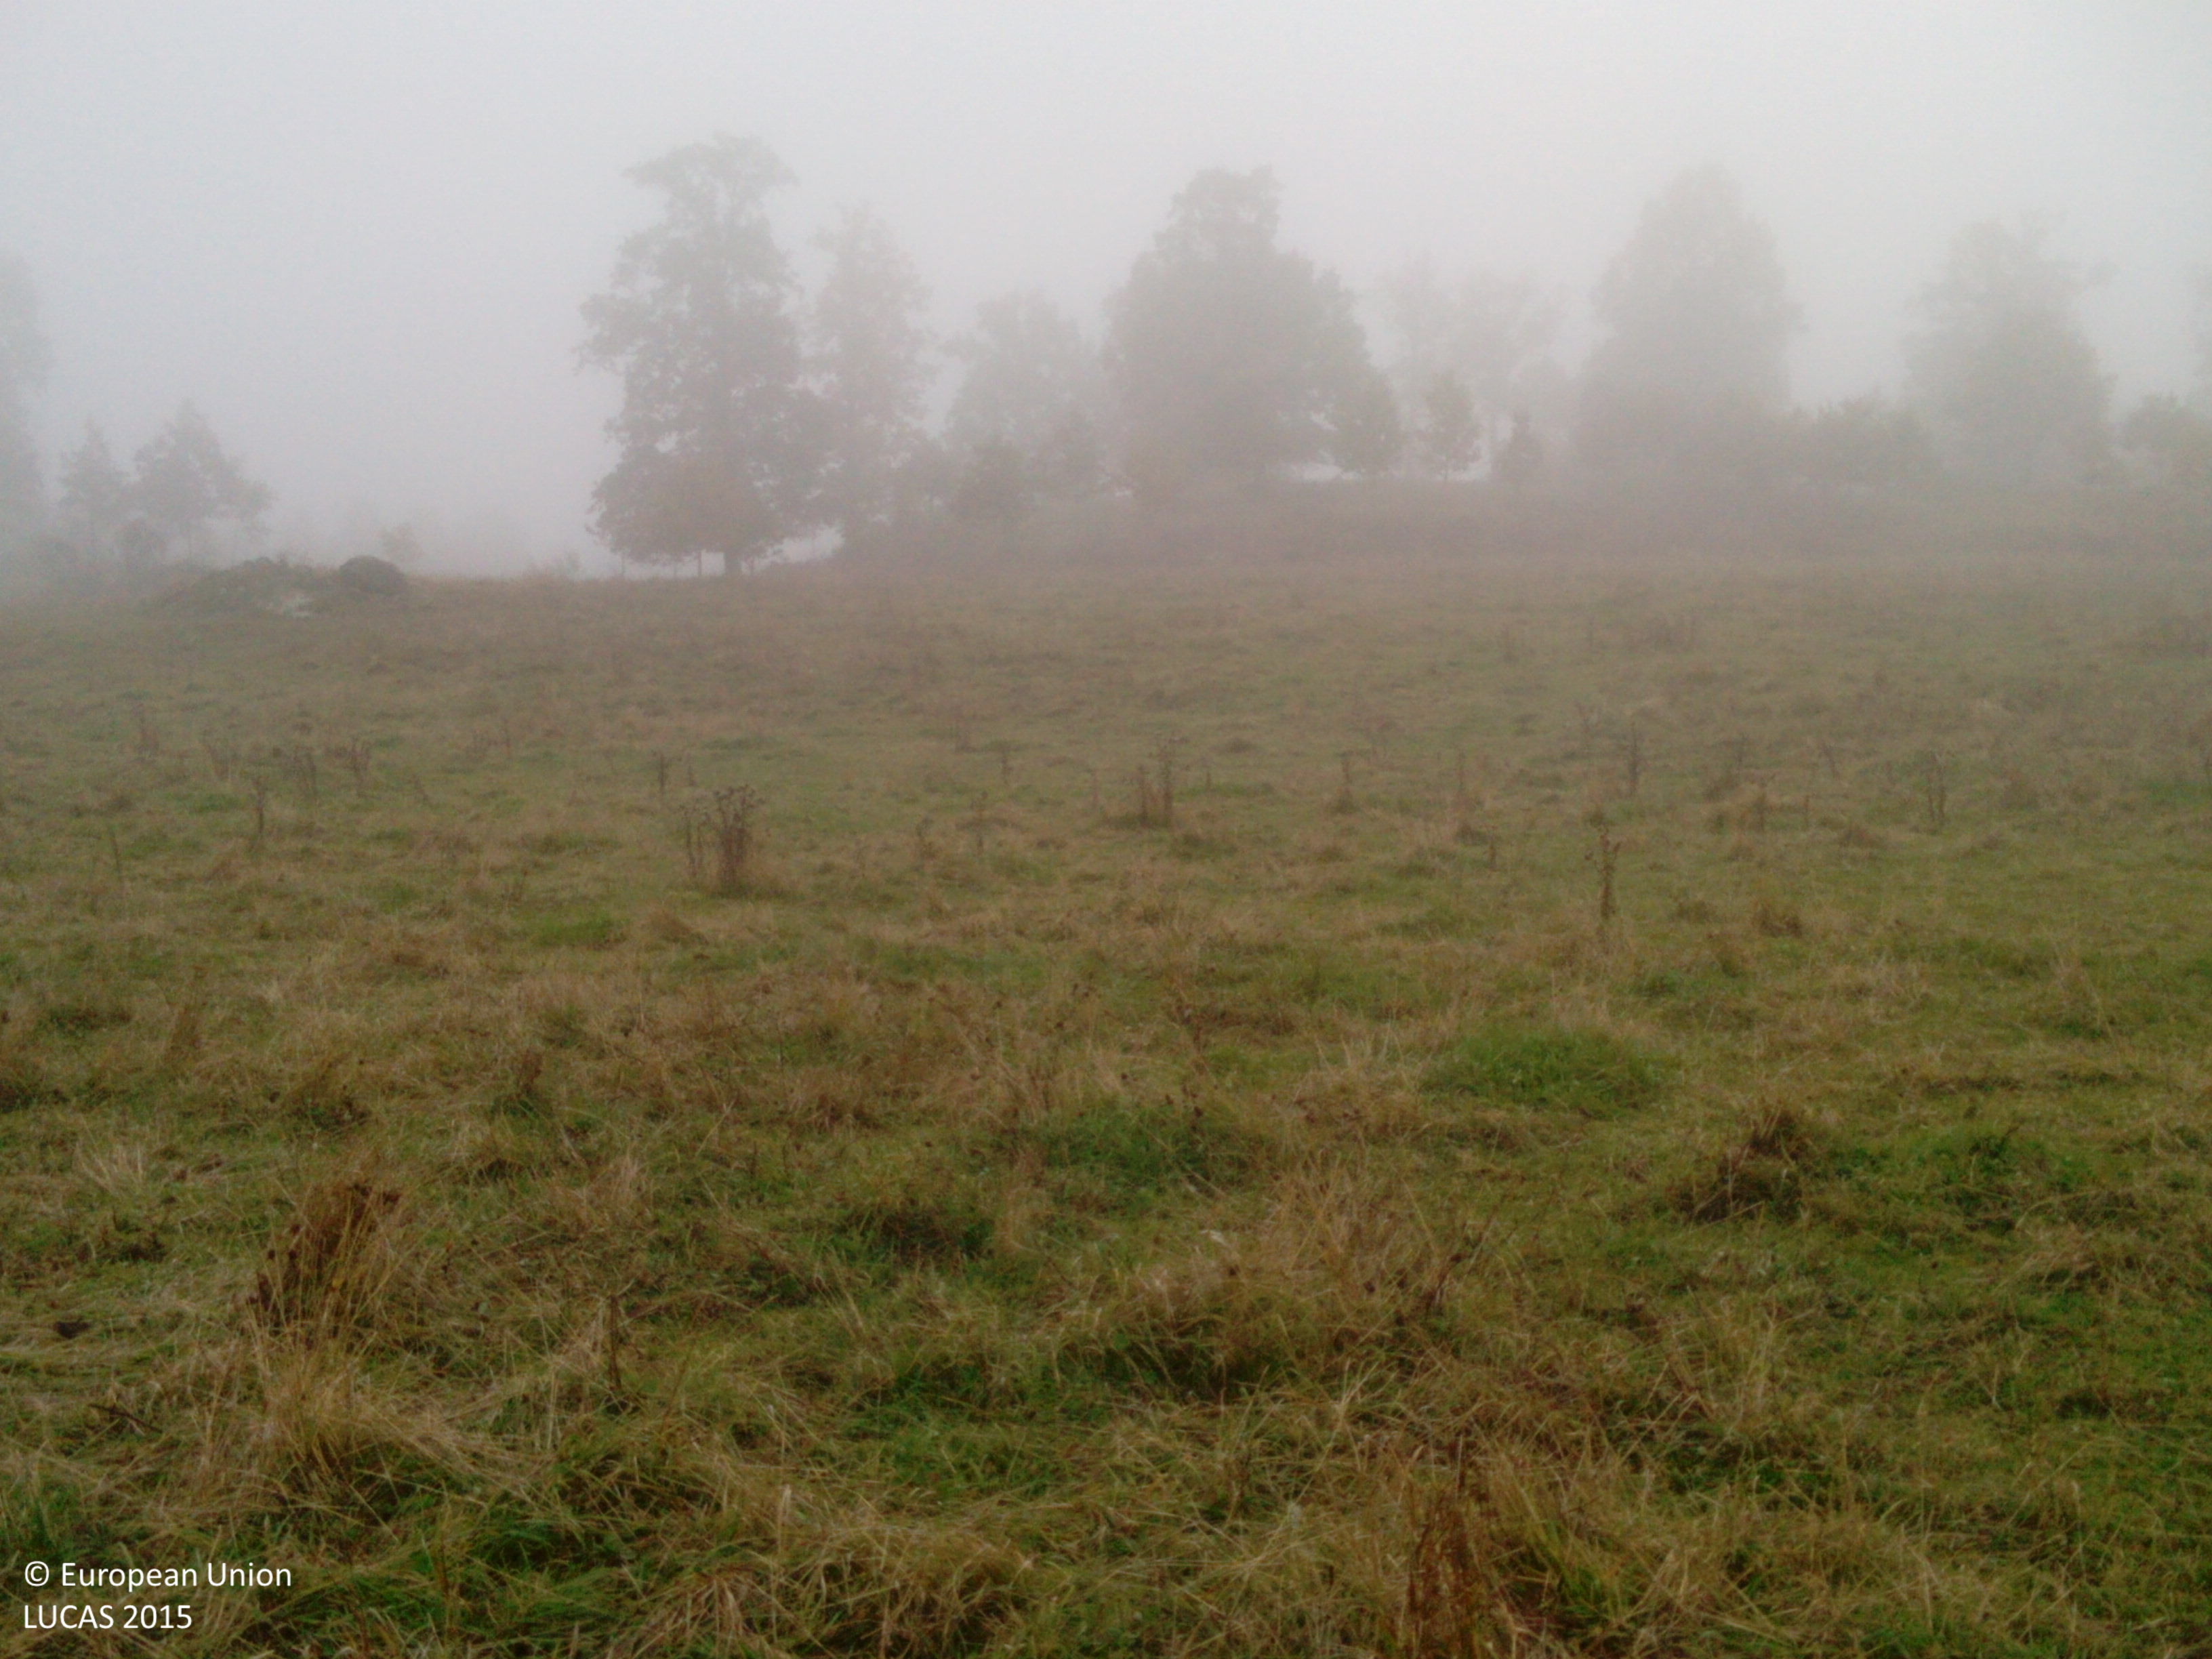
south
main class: Grassland
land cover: Grassland without tree/shrub cover
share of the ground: > 75 %
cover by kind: herbaceous plants 100 %
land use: Agriculture (excluding fallow land and kitchen gardens)
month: October
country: SE
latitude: 58.9301
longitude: 16.4744
